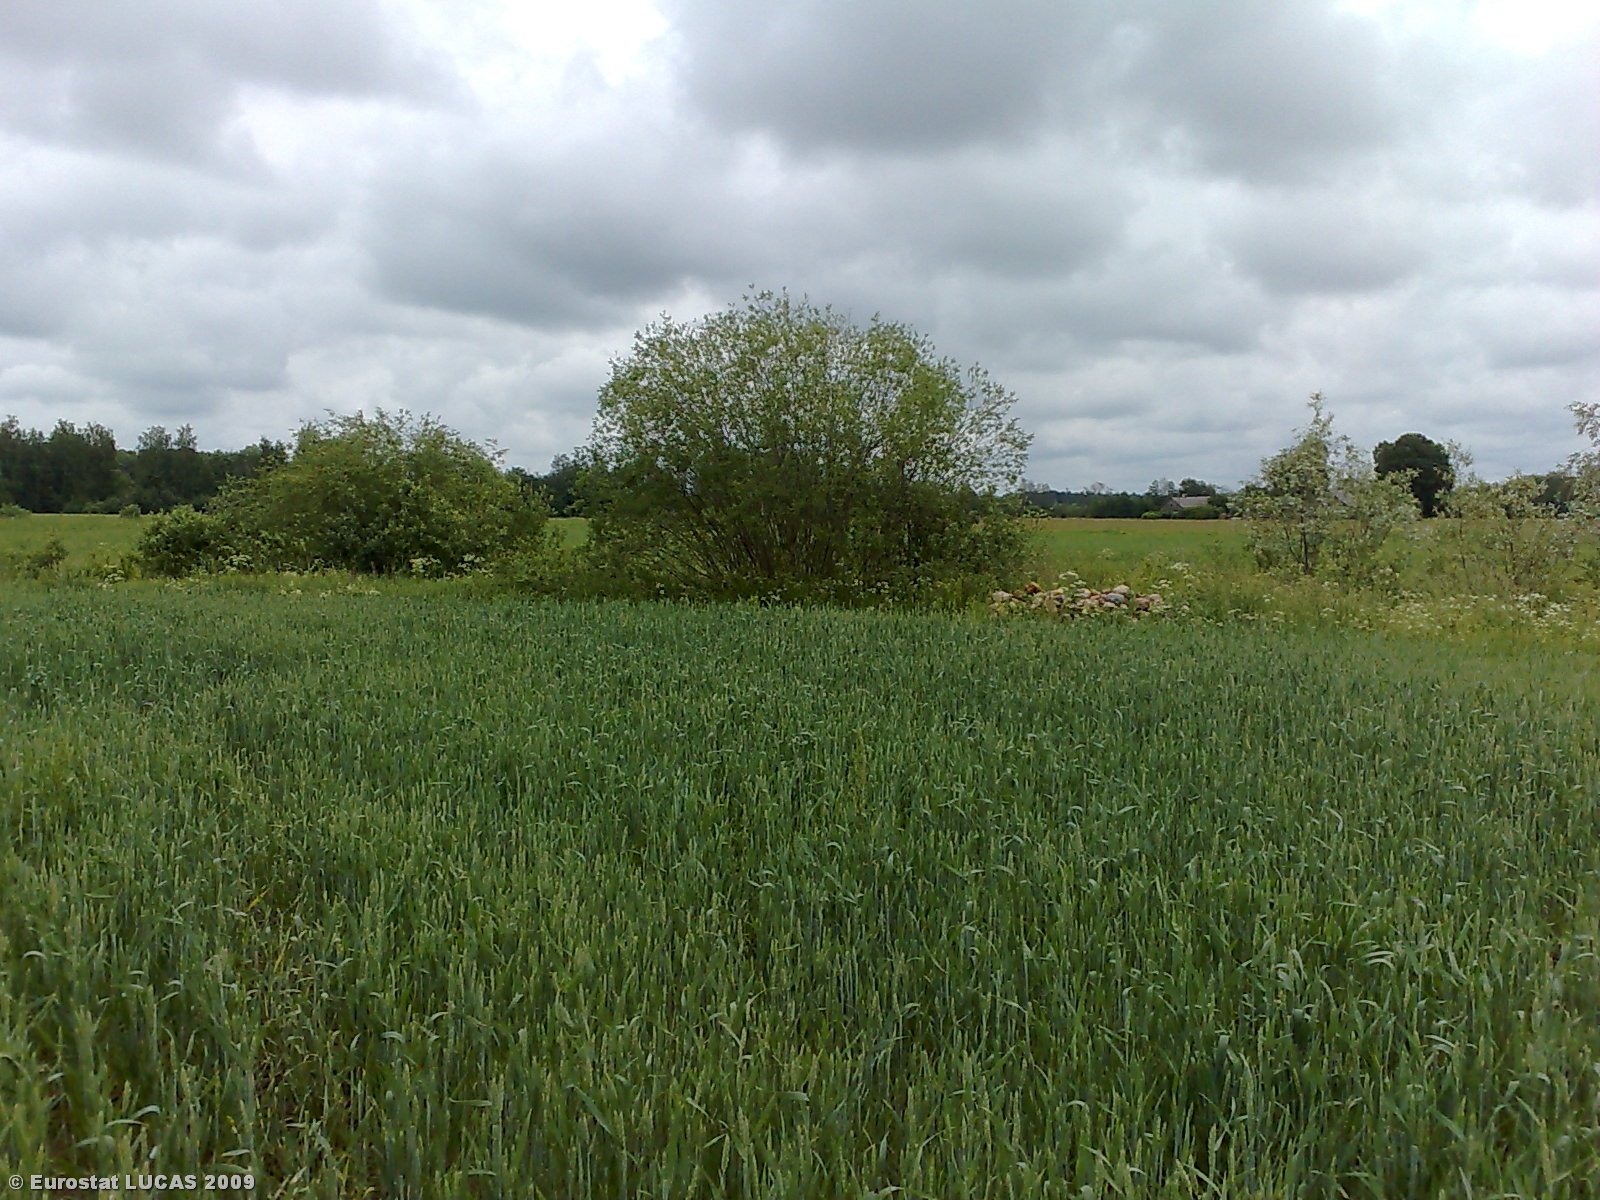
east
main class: Cropland
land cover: Common wheat
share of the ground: > 75 %
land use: Agriculture (excluding fallow land and kitchen gardens)
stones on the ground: < 10 %
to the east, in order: Common wheat; Grass margins; Single bushes/trees; Ditches and canals; Grass margins; Barley; Grassland with sparse tree/shrub cover; Barley; Single bushes/trees; Electric lines; Barley
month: June
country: LT
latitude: 56.0046
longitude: 23.9581
